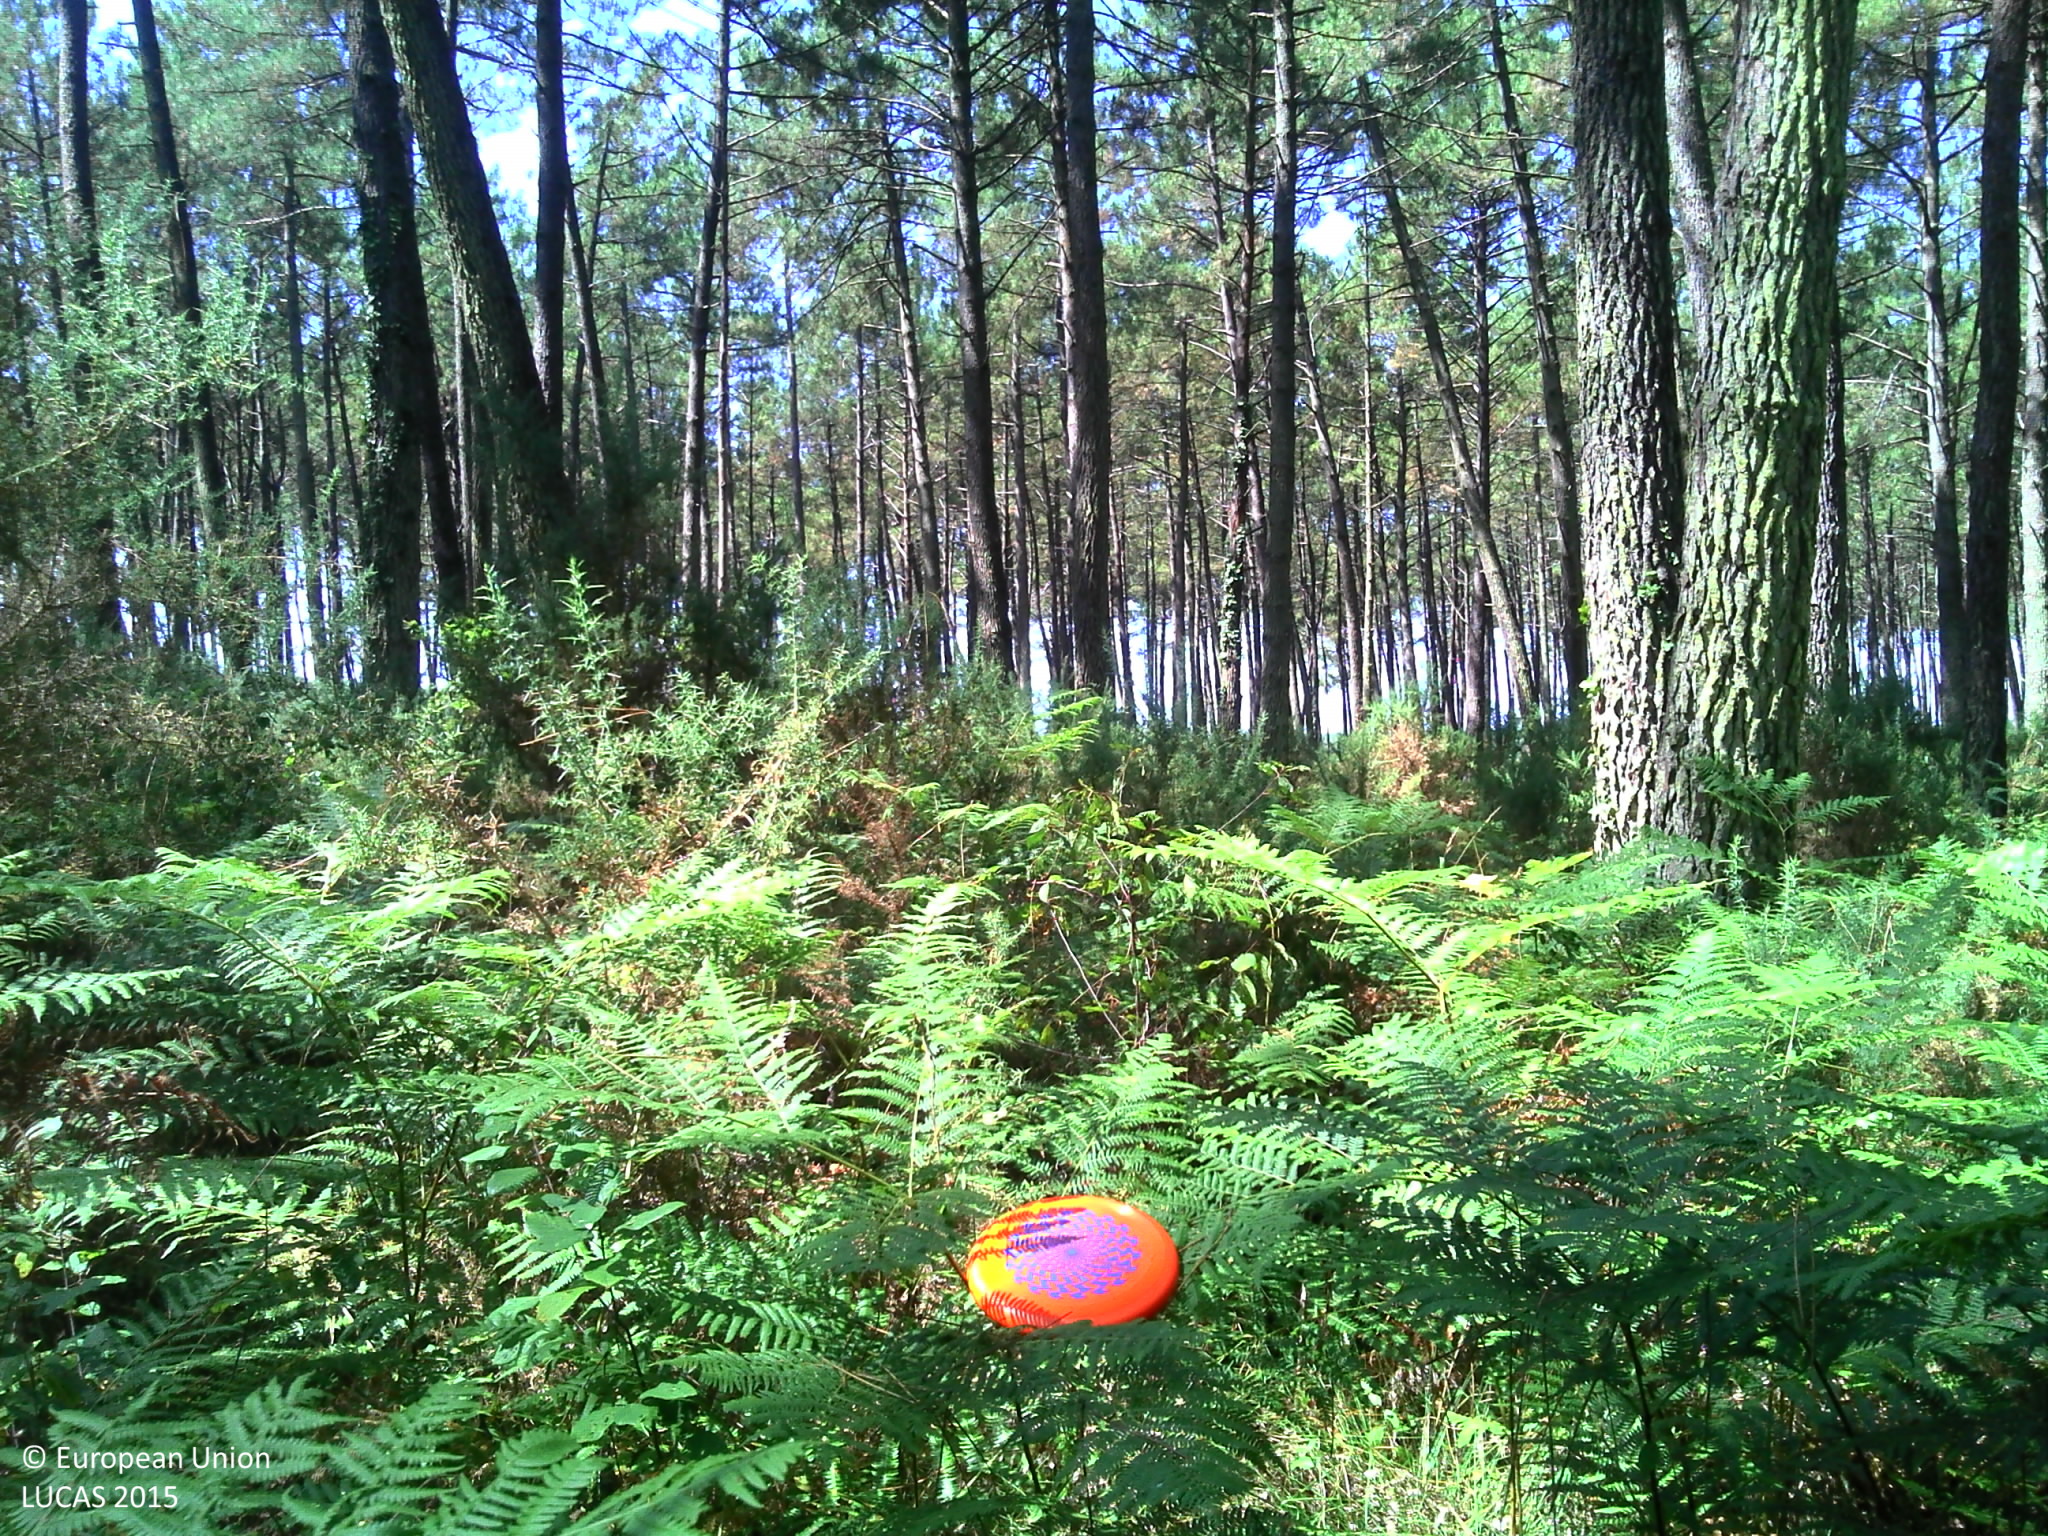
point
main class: Woodland
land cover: Pine dominated coniferous woodland
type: coniferous forest of the mediterranean region
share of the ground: > 75 %
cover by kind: coniferous forest trees 80 %, shrubs 10 %, herbaceous plants 10 %
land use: Forestry
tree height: > 5 m
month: July
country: FR
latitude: 44.1746
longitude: -1.2401
